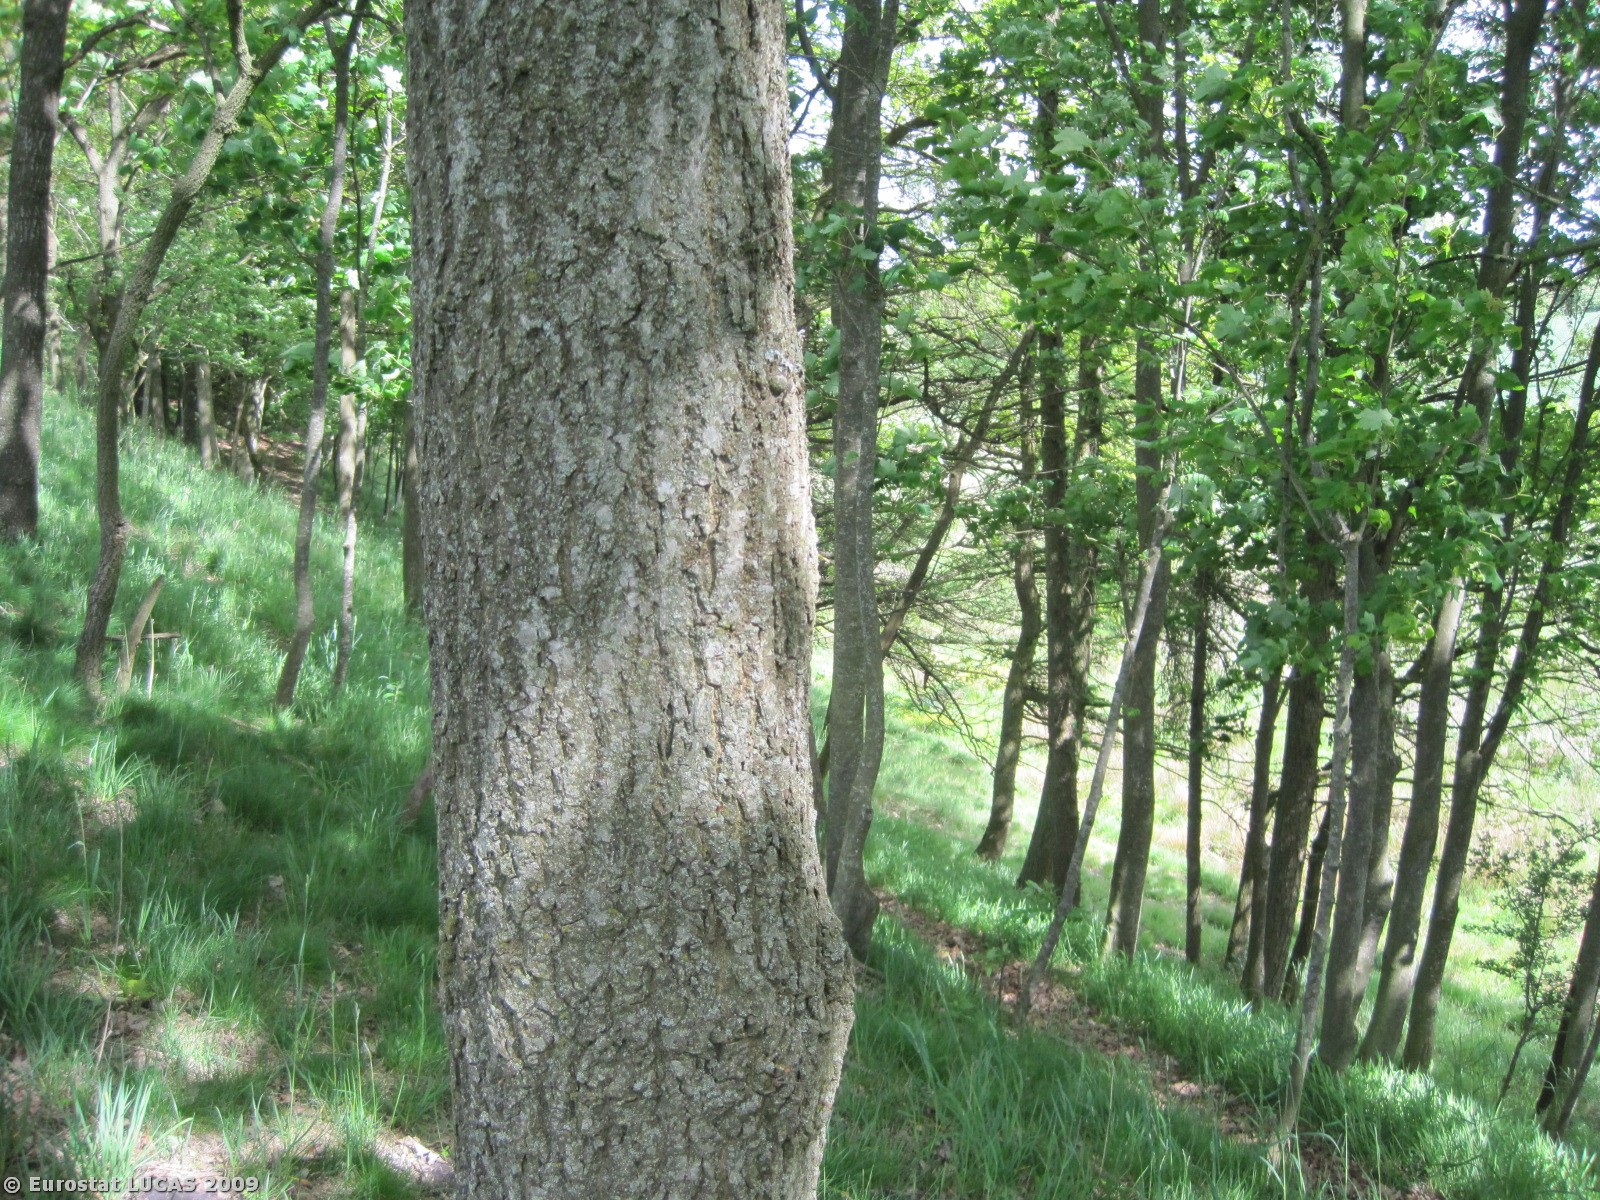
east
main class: Woodland
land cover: Broadleaved woodland
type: plantations and self-sown exotic forest
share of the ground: > 75 %
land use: Unused
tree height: > 5 m
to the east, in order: Broadleaved woodland; Grassland without tree/shrub cover; Fences; Grassland without tree/shrub cover; Fences; Grassland without tree/shrub cover; Ditches and canals; Grassland without tree/shrub cover; Broadleaved woodland; Grassland without tree/shrub cover
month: May
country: DK
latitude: 56.7270
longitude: 9.8858
